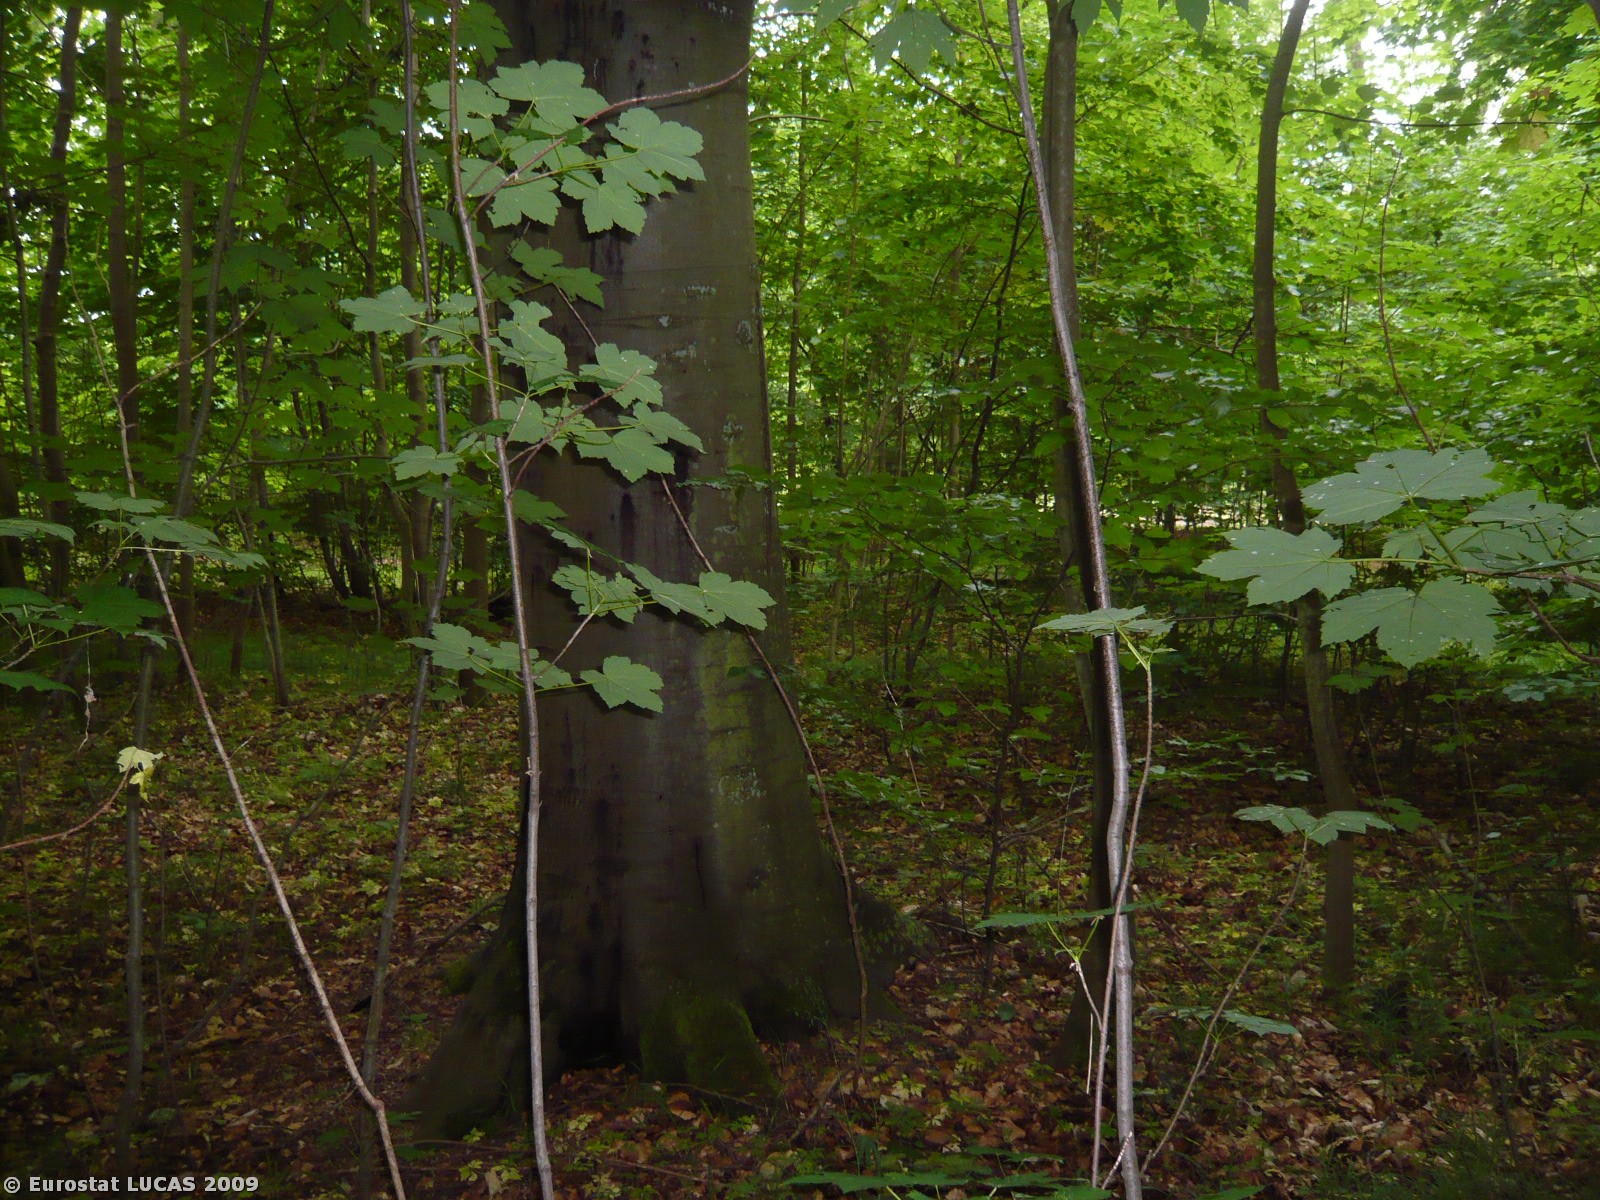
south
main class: Woodland
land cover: Broadleaved woodland
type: mesophytic deciduous forest
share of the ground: > 75 %
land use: Forestry
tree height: > 5 m
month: June
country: DK
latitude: 54.7007
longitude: 11.8144
